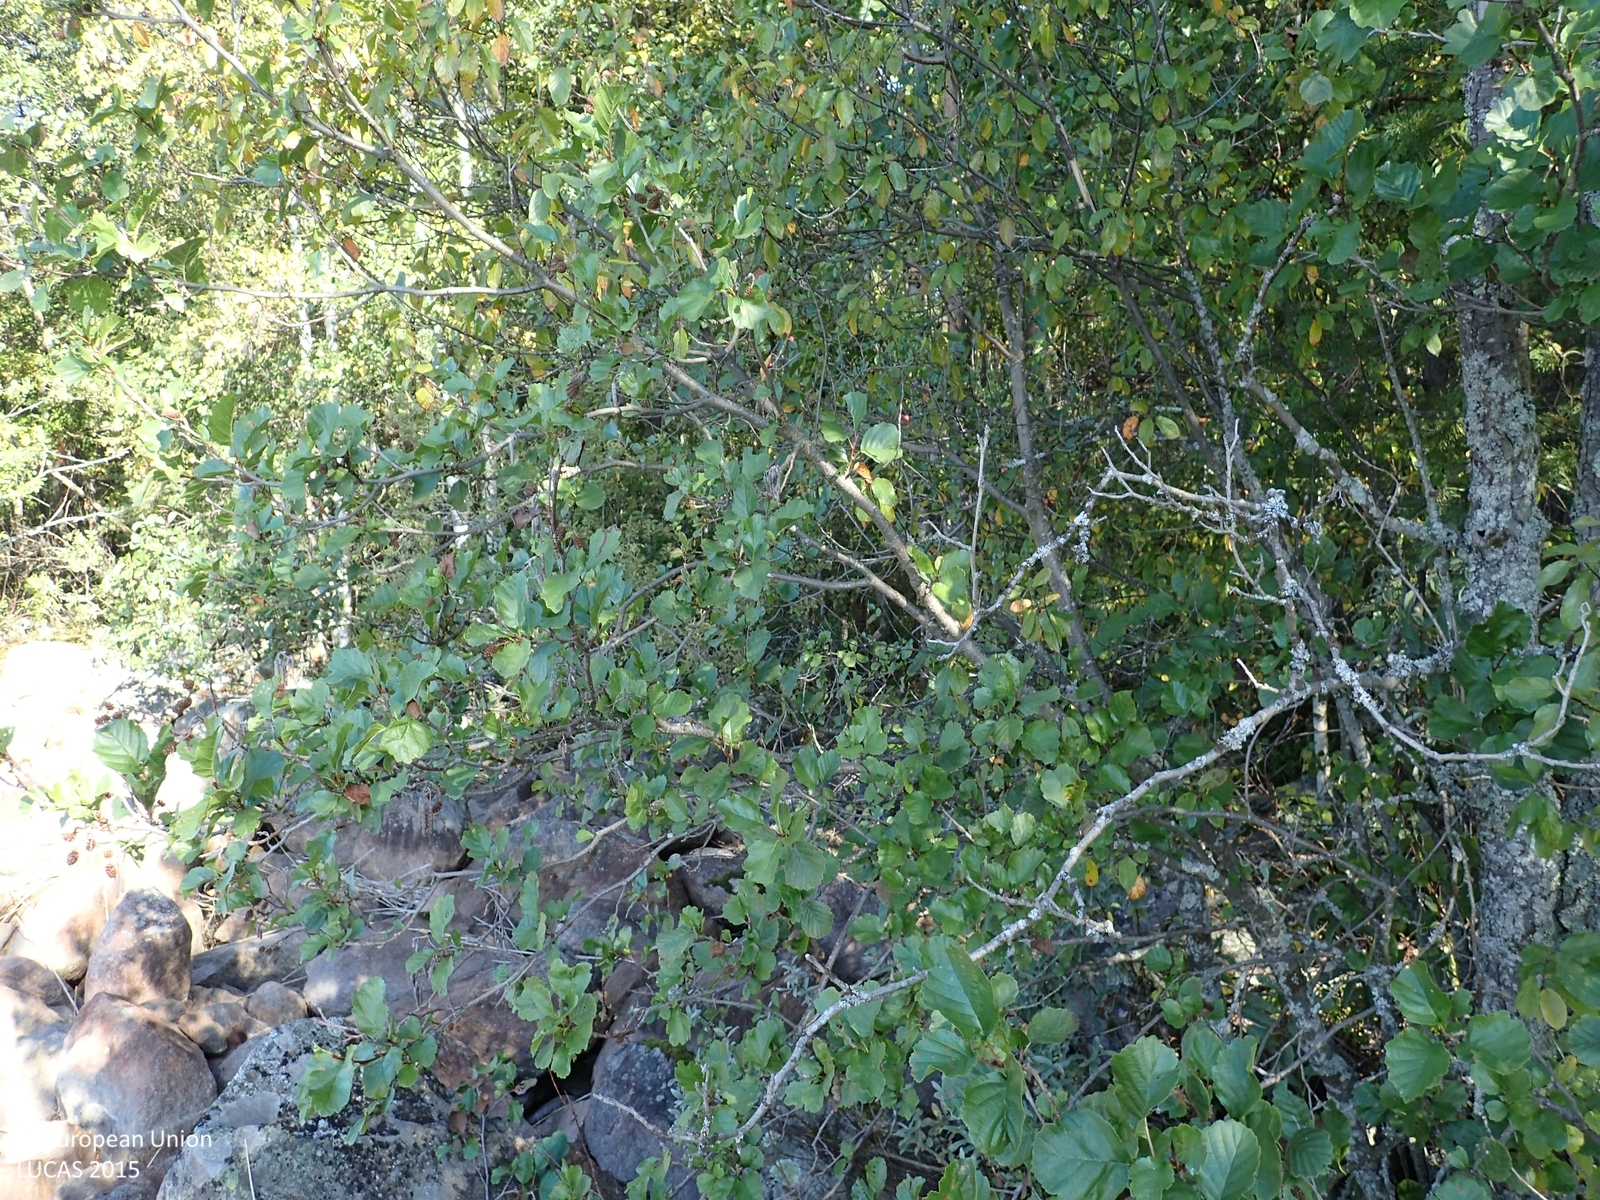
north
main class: Woodland
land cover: Broadleaved woodland
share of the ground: > 75 %
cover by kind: broadleaved forest trees 80 %, coniferous forest trees 10 %, shrubs 10 %
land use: Semi-natural and natural areas not in use
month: September
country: FI
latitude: 63.1394
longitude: 25.2358
